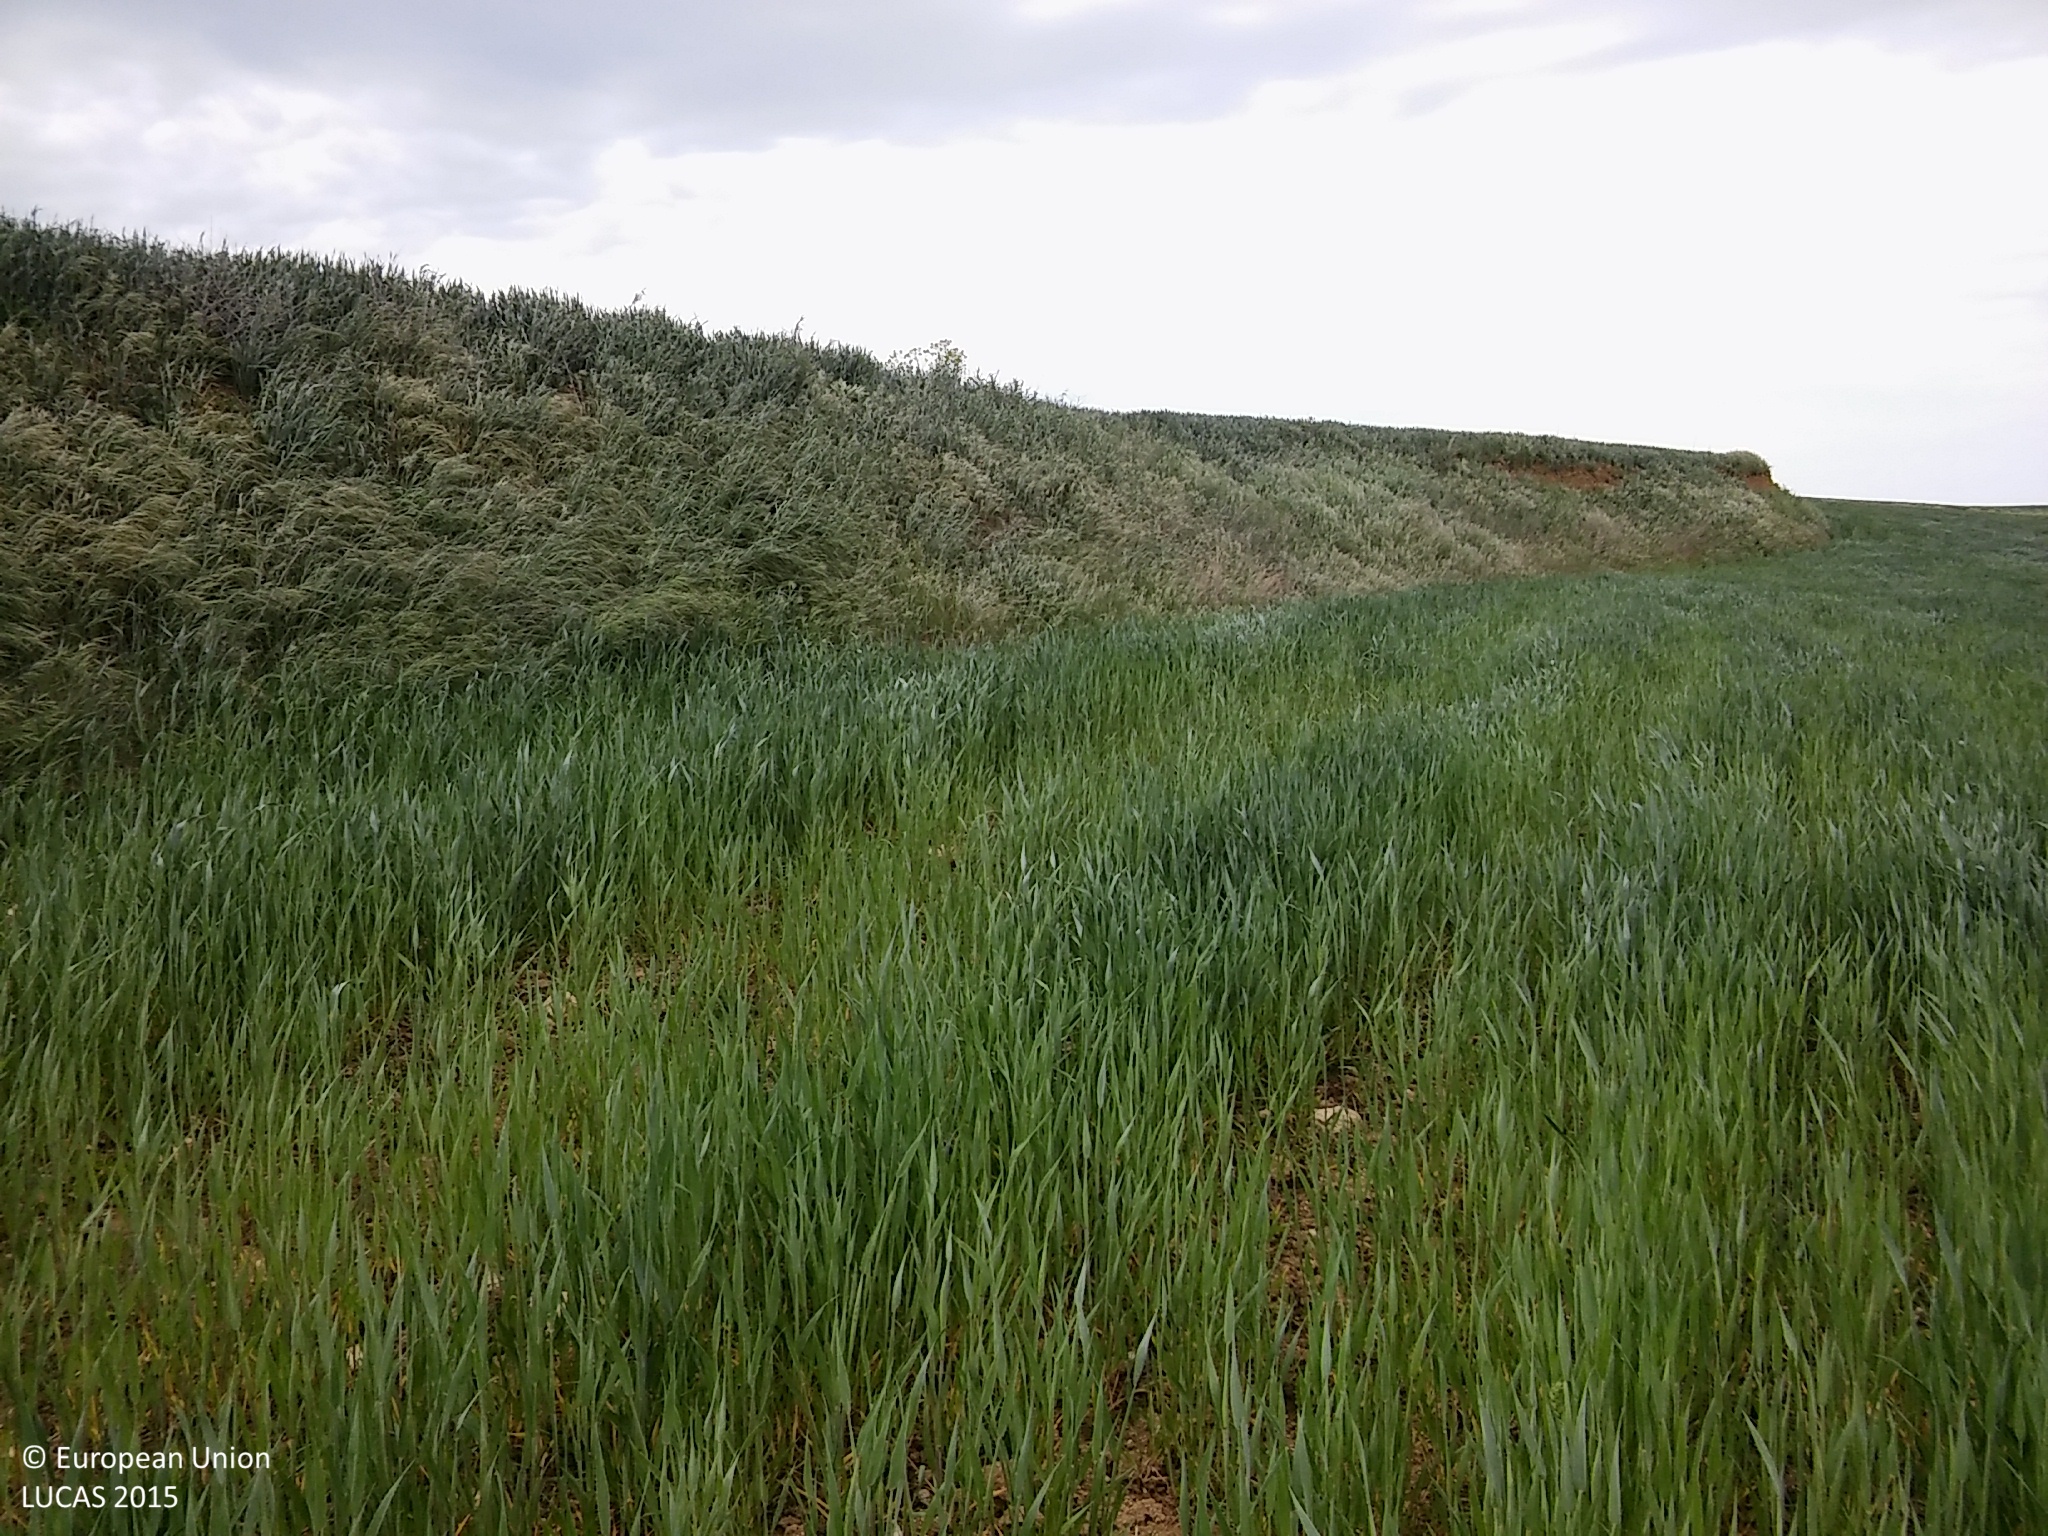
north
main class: Cropland
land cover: Common wheat
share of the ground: > 75 %
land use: Agriculture (excluding fallow land and kitchen gardens)
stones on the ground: < 10 %
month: May
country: ES
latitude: 41.1028
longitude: -4.0418
